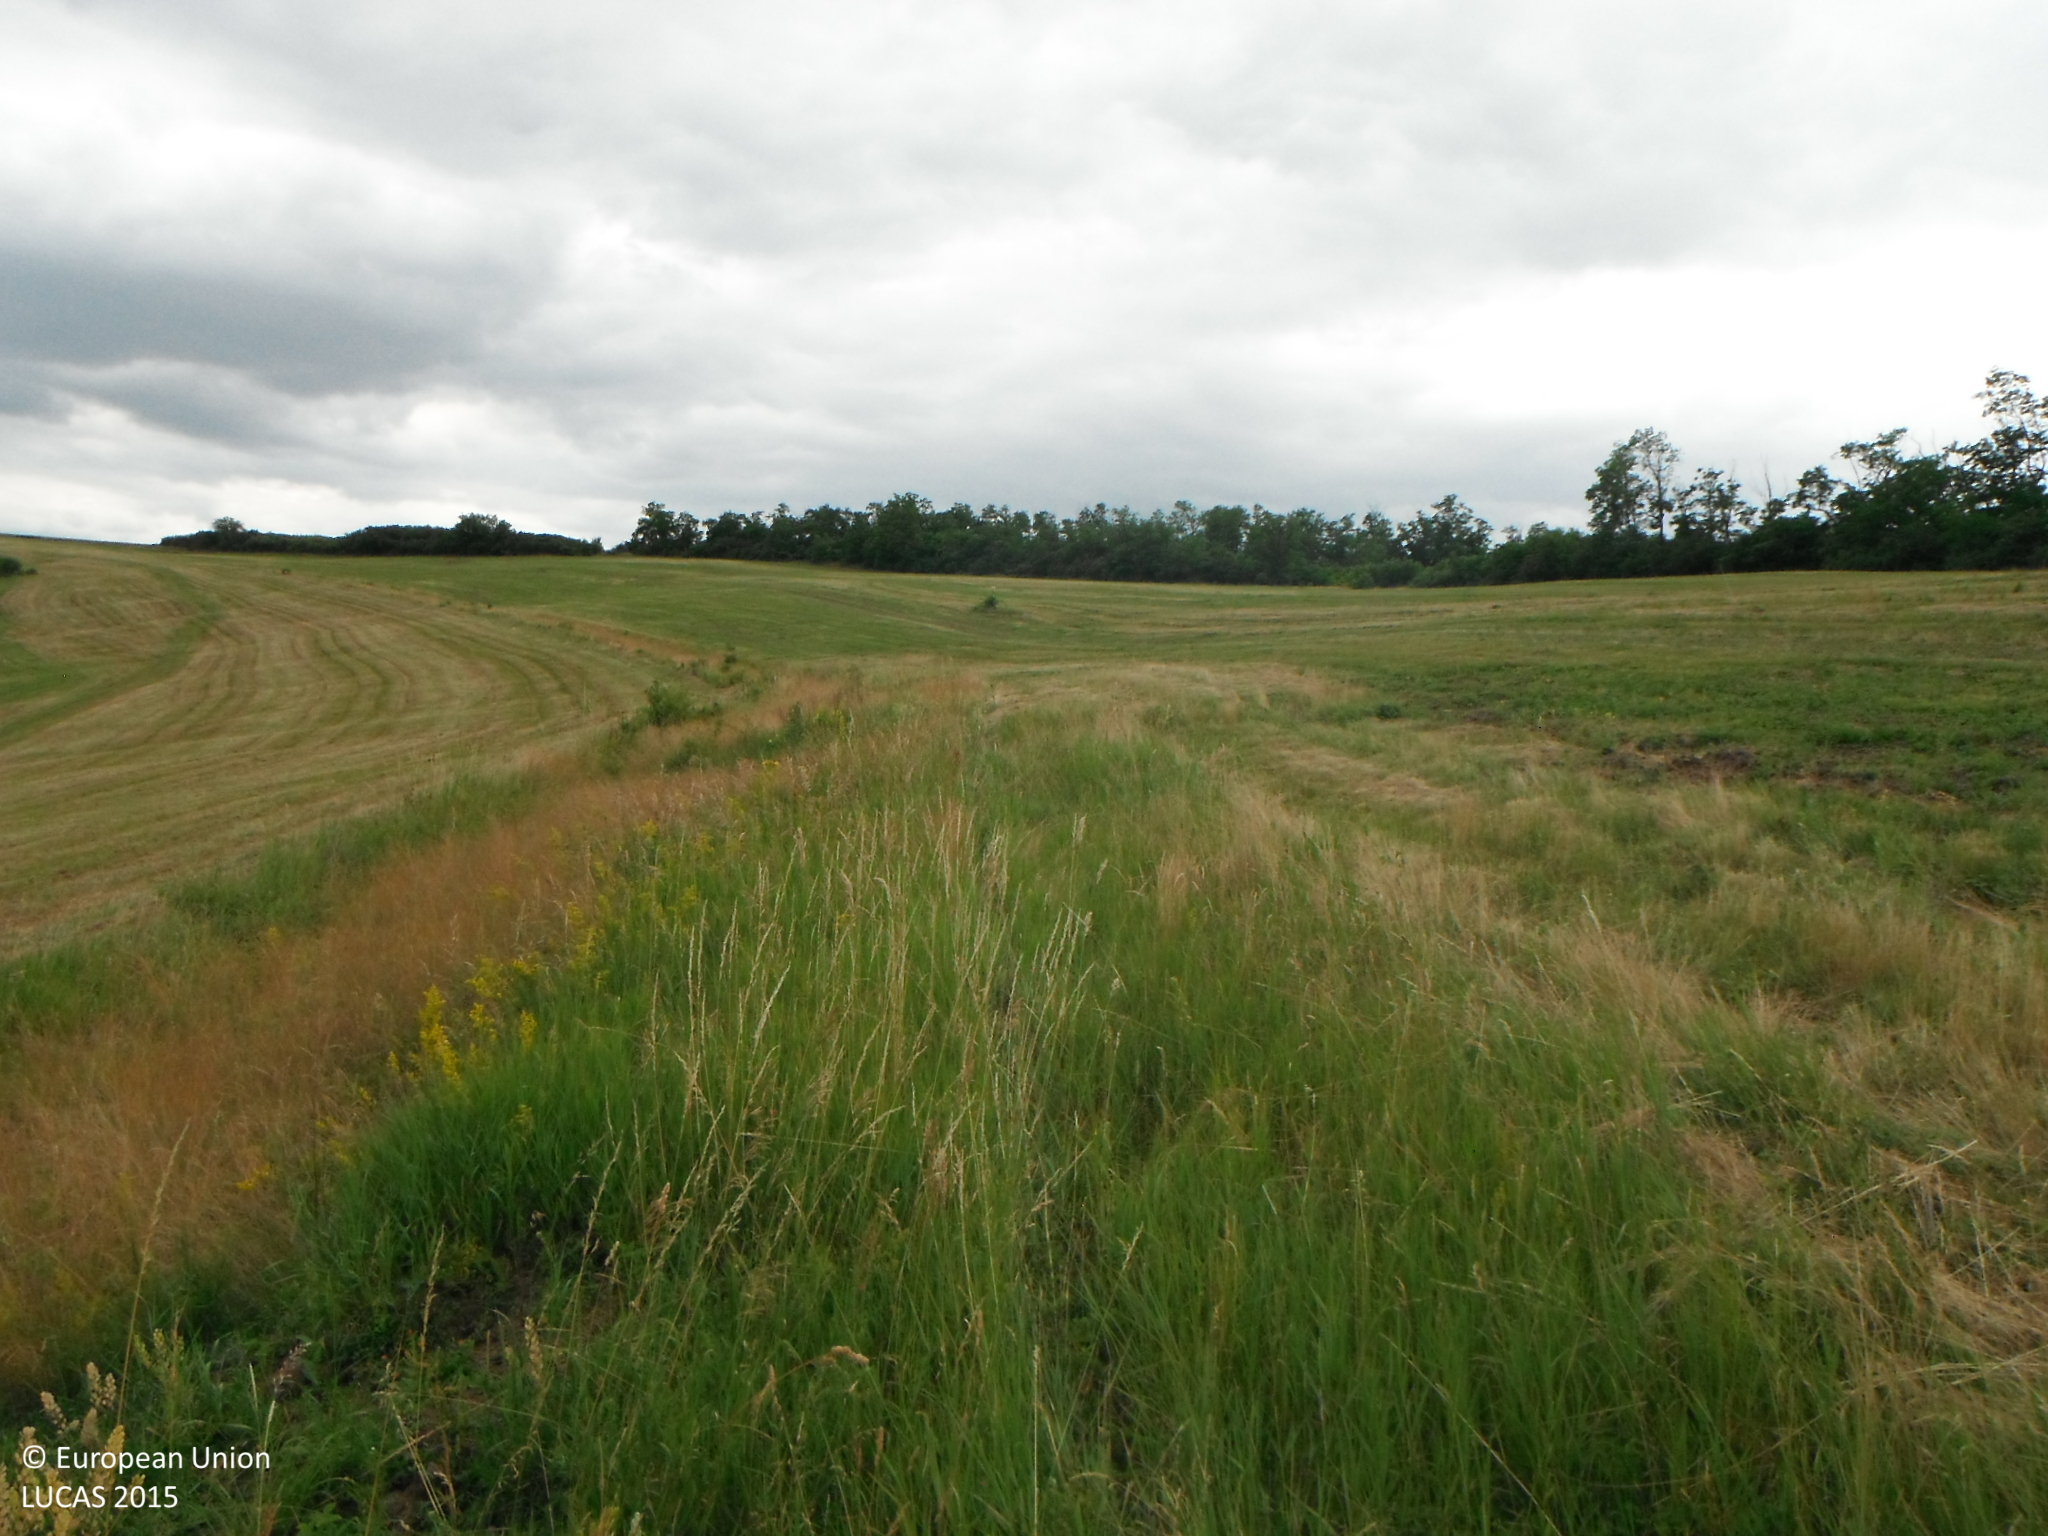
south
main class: Grassland
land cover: Grassland without tree/shrub cover
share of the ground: > 75 %
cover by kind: herbaceous plants 100 %
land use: Agriculture (excluding fallow land and kitchen gardens)
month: June
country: SK
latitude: 48.1701
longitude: 18.9073
